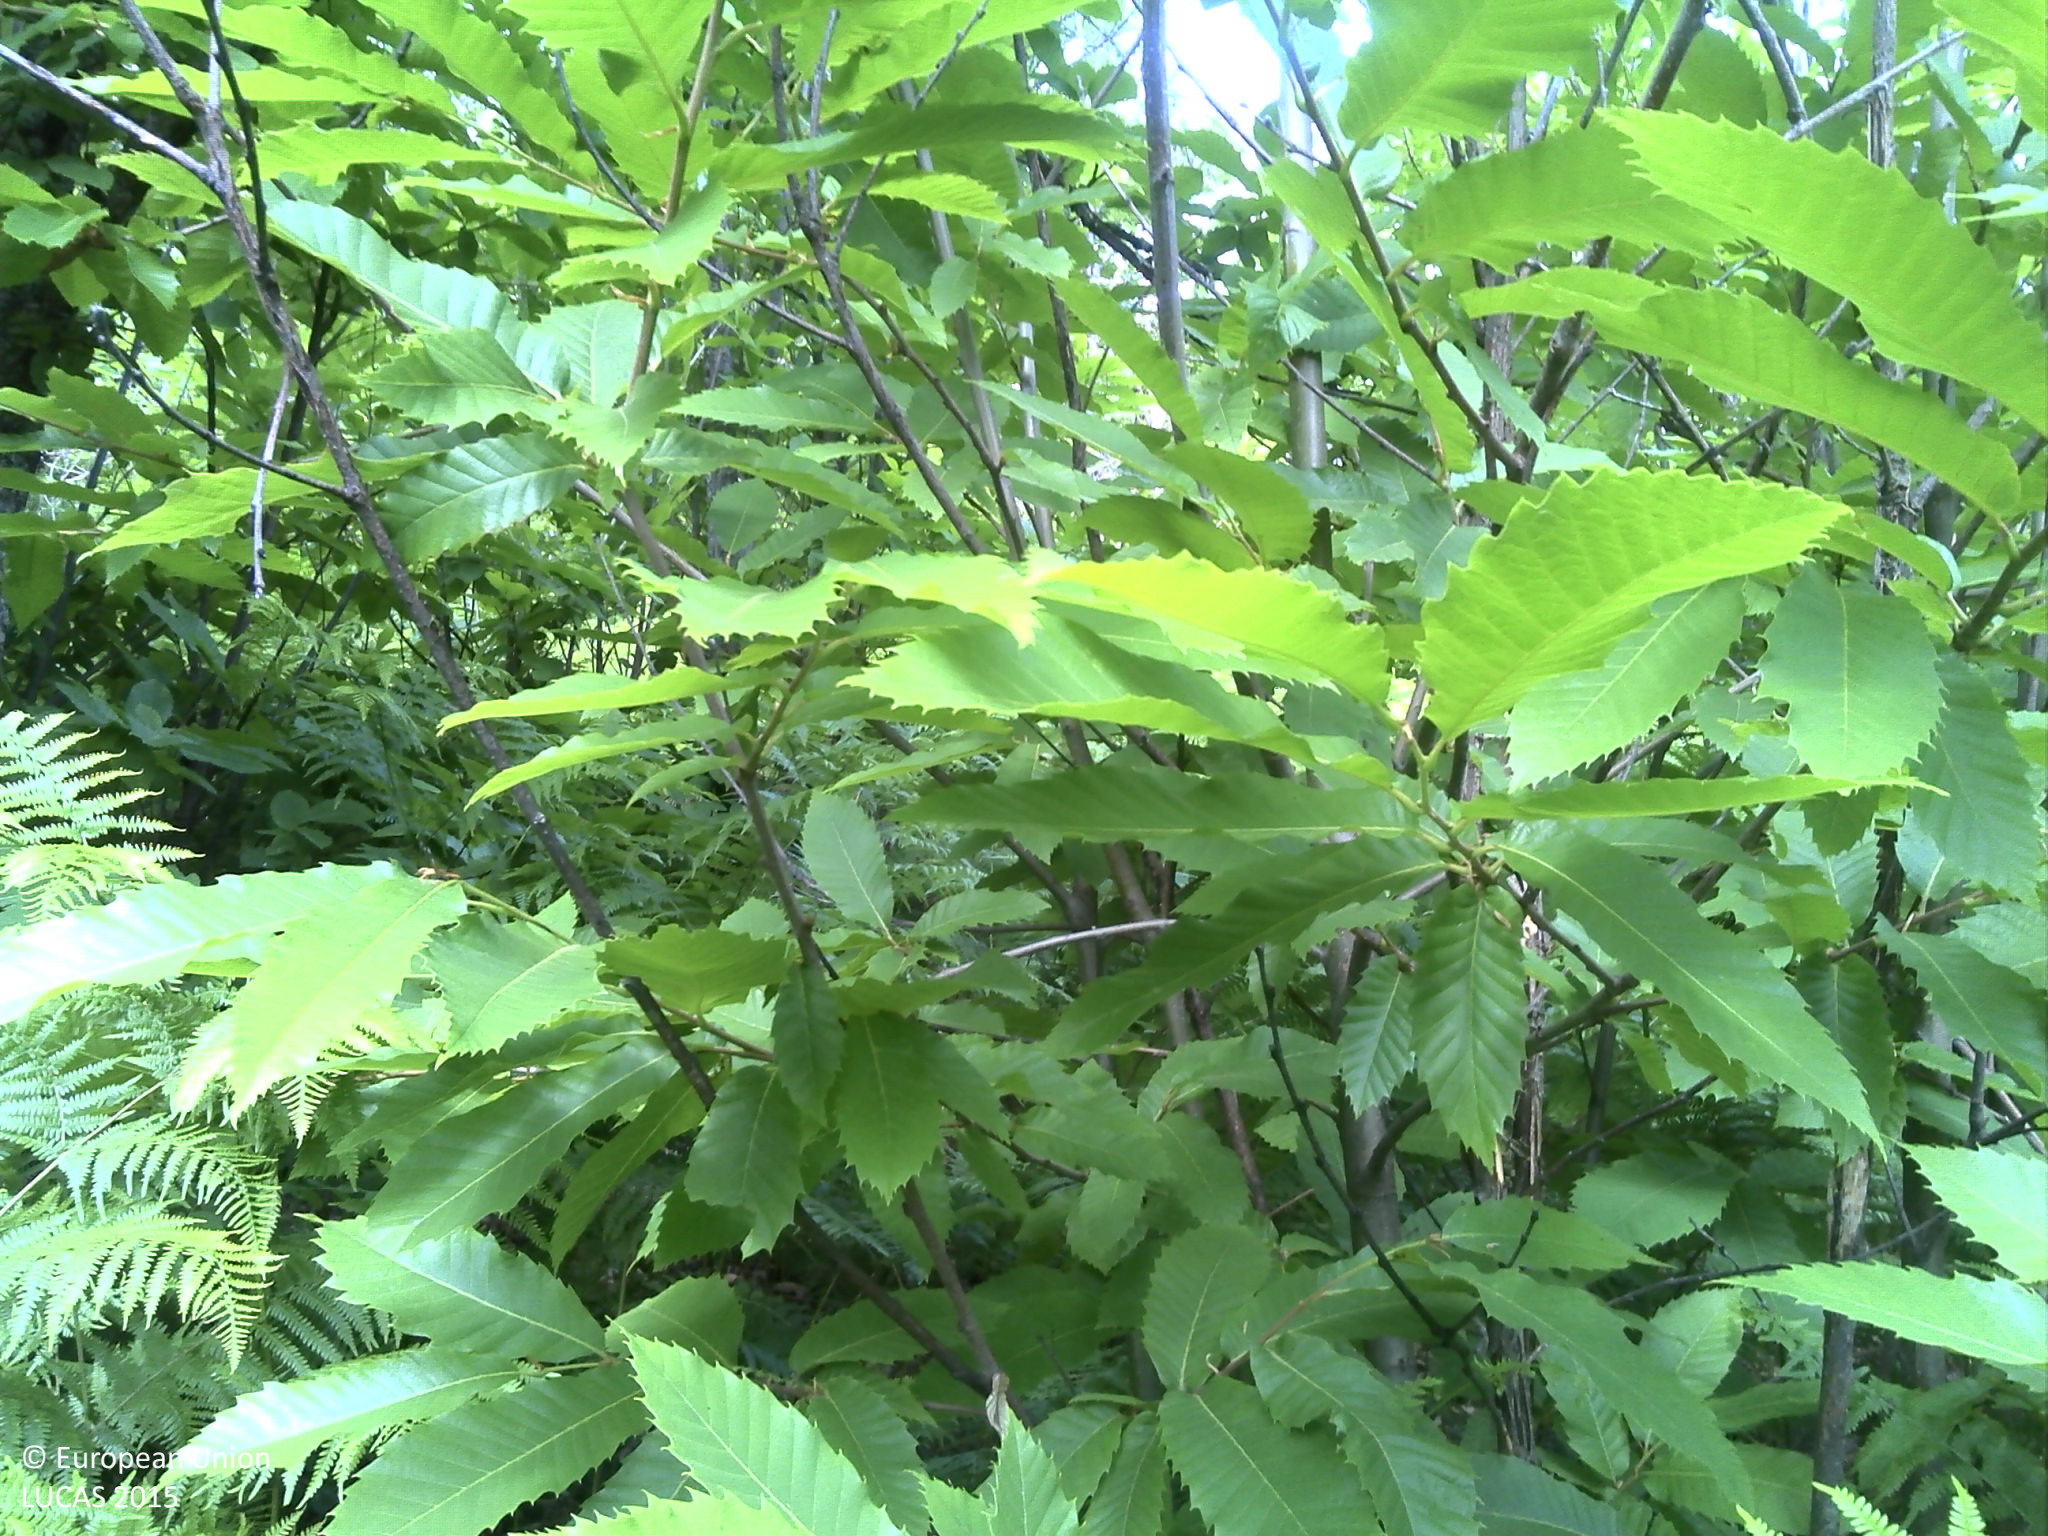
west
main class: Woodland
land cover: Broadleaved woodland
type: thermophilous deciduous forest
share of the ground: 25 - 50 %
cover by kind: shrubs 70 %, broadleaved forest trees 30 %
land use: Forestry
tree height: > 5 m
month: June
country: PT
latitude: 41.8399
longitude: -6.6209
